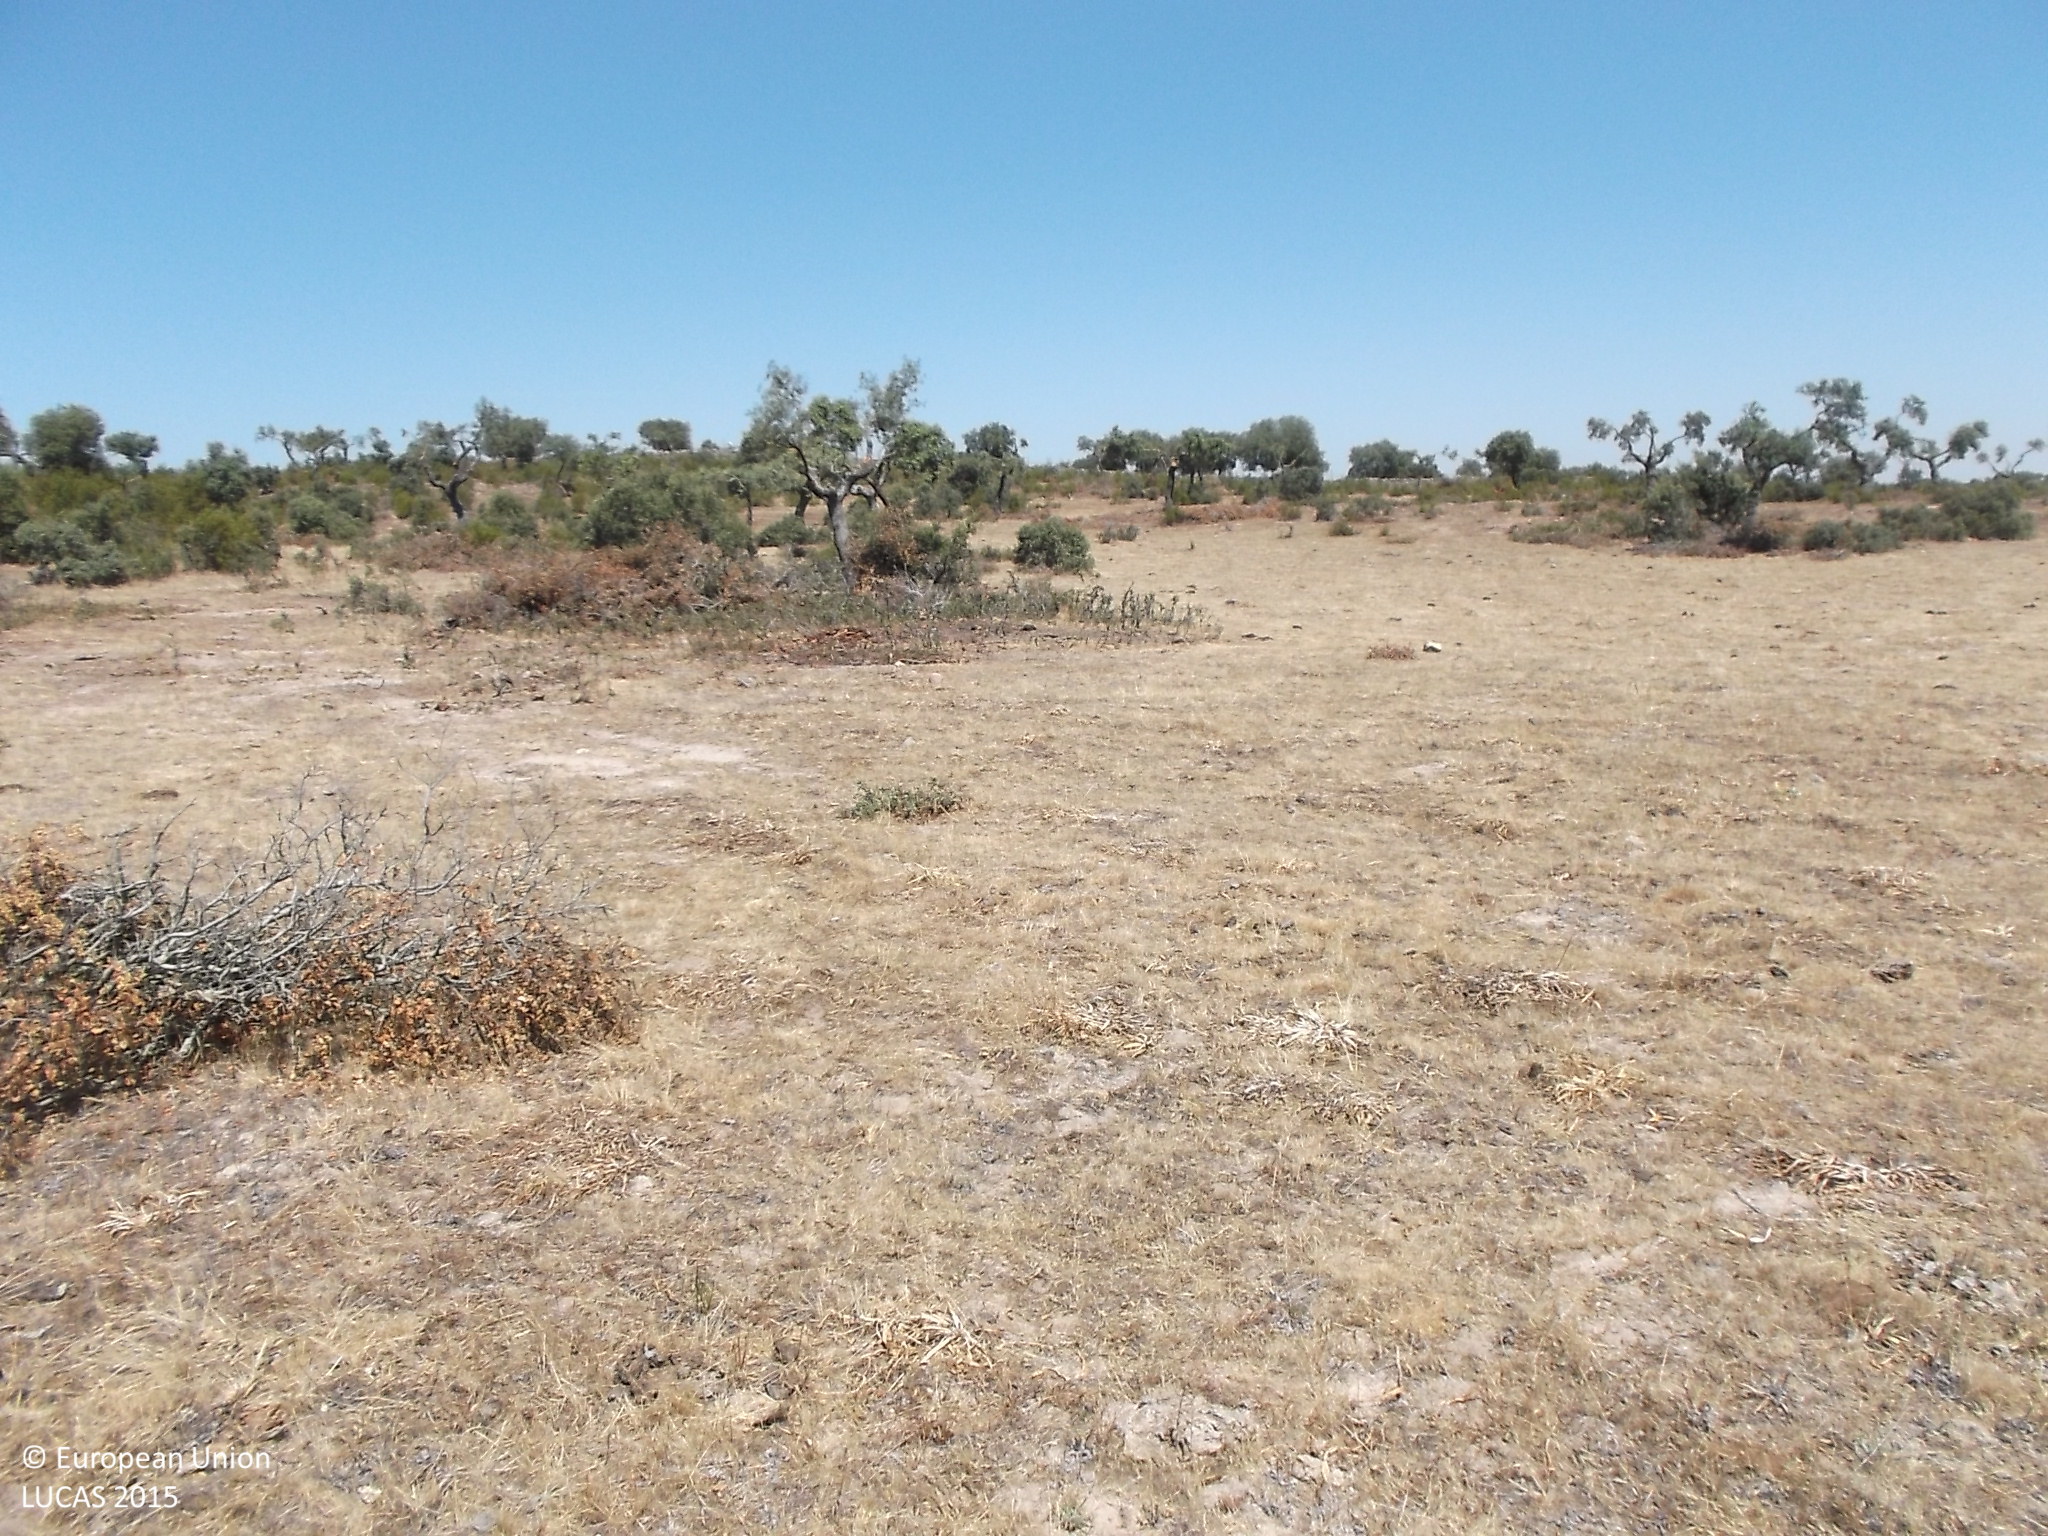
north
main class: Woodland
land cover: Broadleaved woodland
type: broadleaved evergreen forest
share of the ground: 10 - 25 %
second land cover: Grassland without tree/shrub cover
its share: > 75 %
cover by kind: herbaceous plants 80 %, broadleaved forest trees 20 %
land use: Forestry
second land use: Agriculture (excluding fallow land and kitchen gardens)
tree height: < 5 m
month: July
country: ES
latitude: 41.3456
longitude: -5.8255
